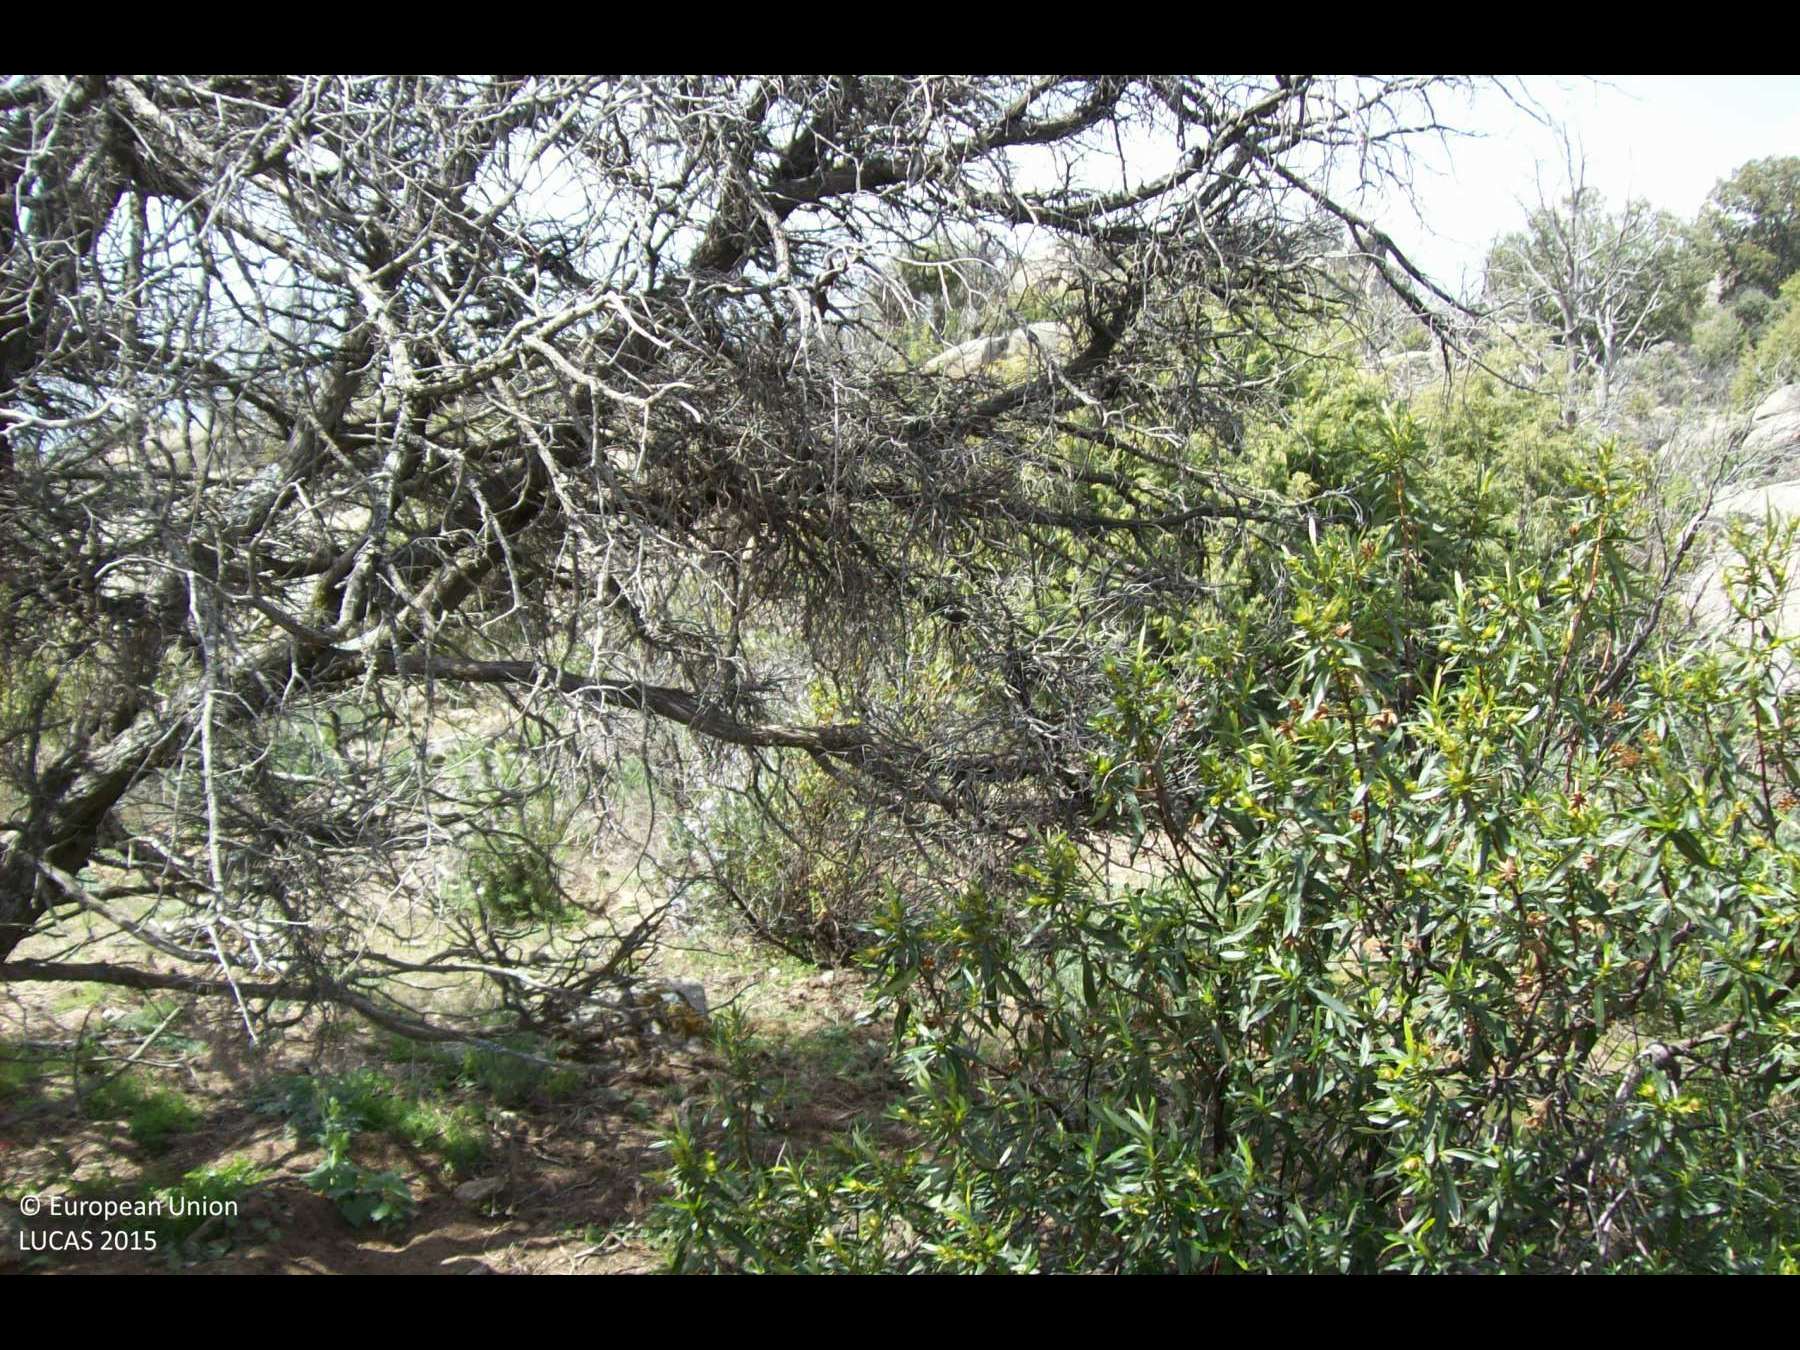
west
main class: Shrubland
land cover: Shrubland with sparse tree cover
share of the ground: > 75 %
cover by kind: consolidated bare surface 40 %, shrubs 35 %, herbaceous plants 20 %, coniferous forest trees 5 %
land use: Semi-natural and natural areas not in use
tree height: < 5 m
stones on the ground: < 10 %
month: April
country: ES
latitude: 40.6381
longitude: -3.9609
